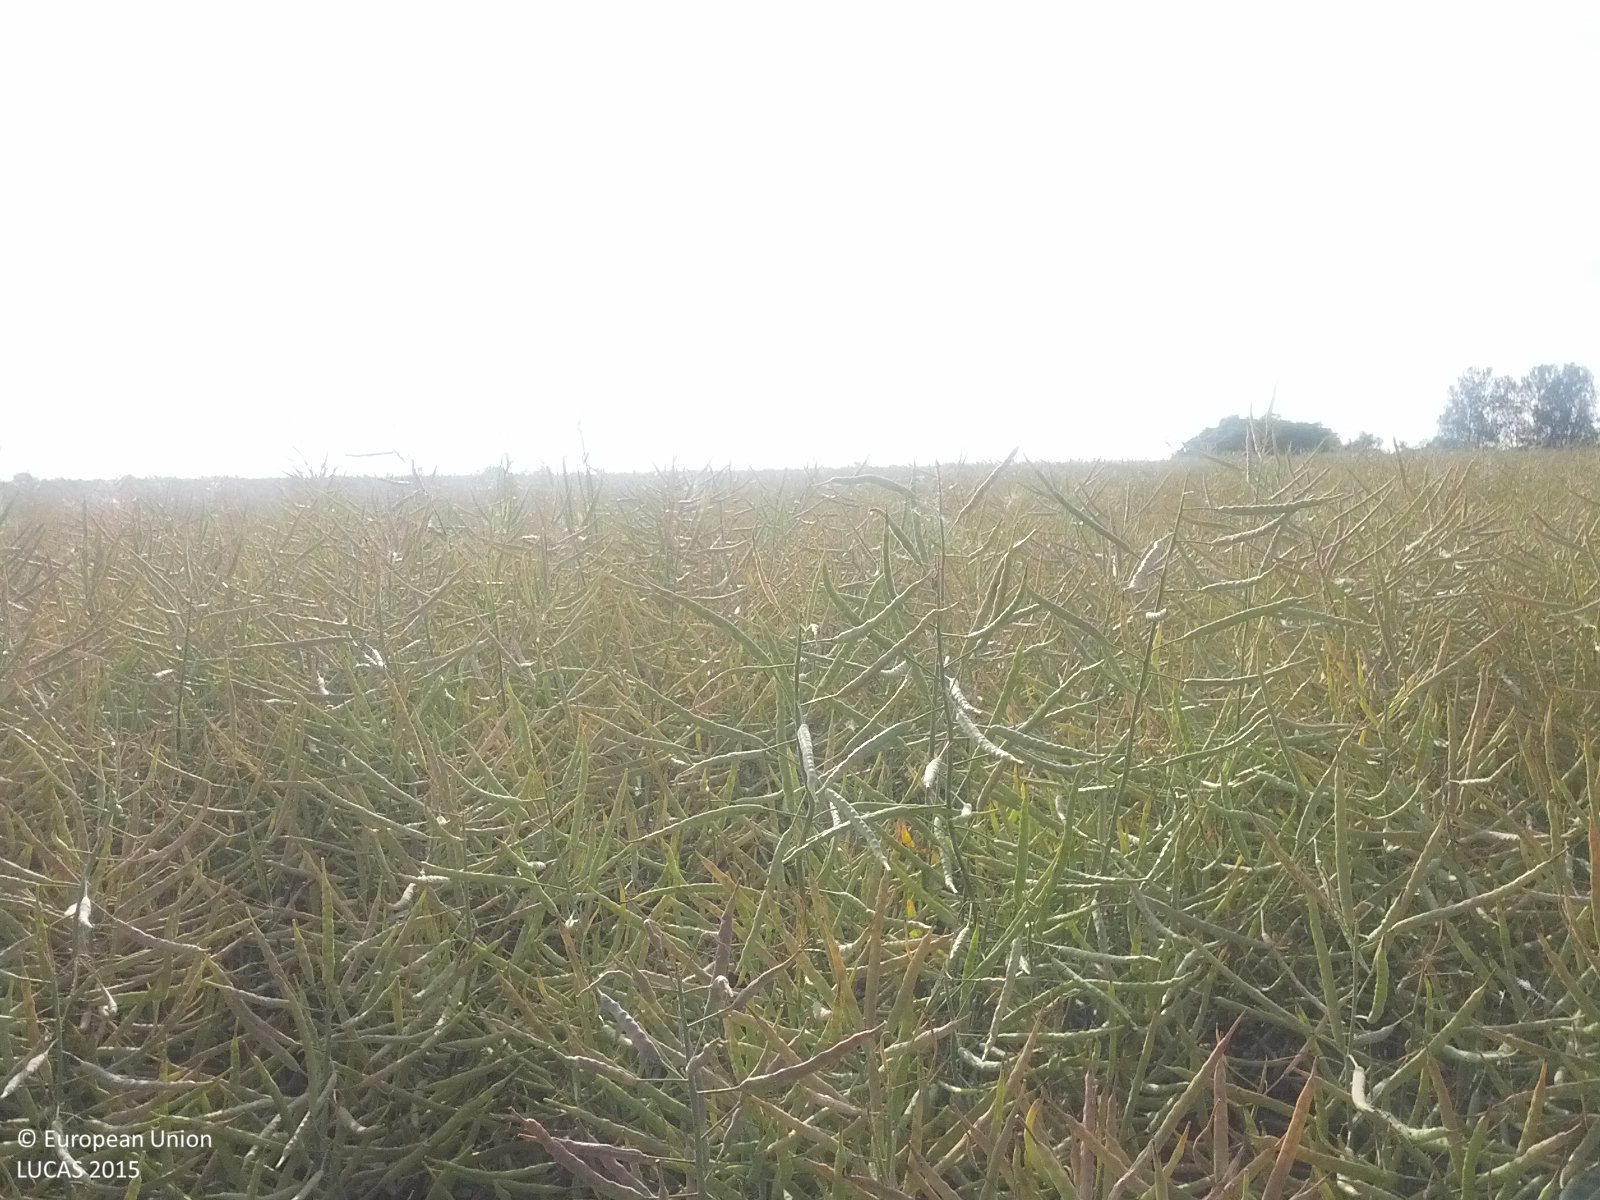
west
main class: Cropland
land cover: Rape and turnip rape
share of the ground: > 75 %
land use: Agriculture (excluding fallow land and kitchen gardens)
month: June
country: AT
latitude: 48.1907
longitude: 16.8540
